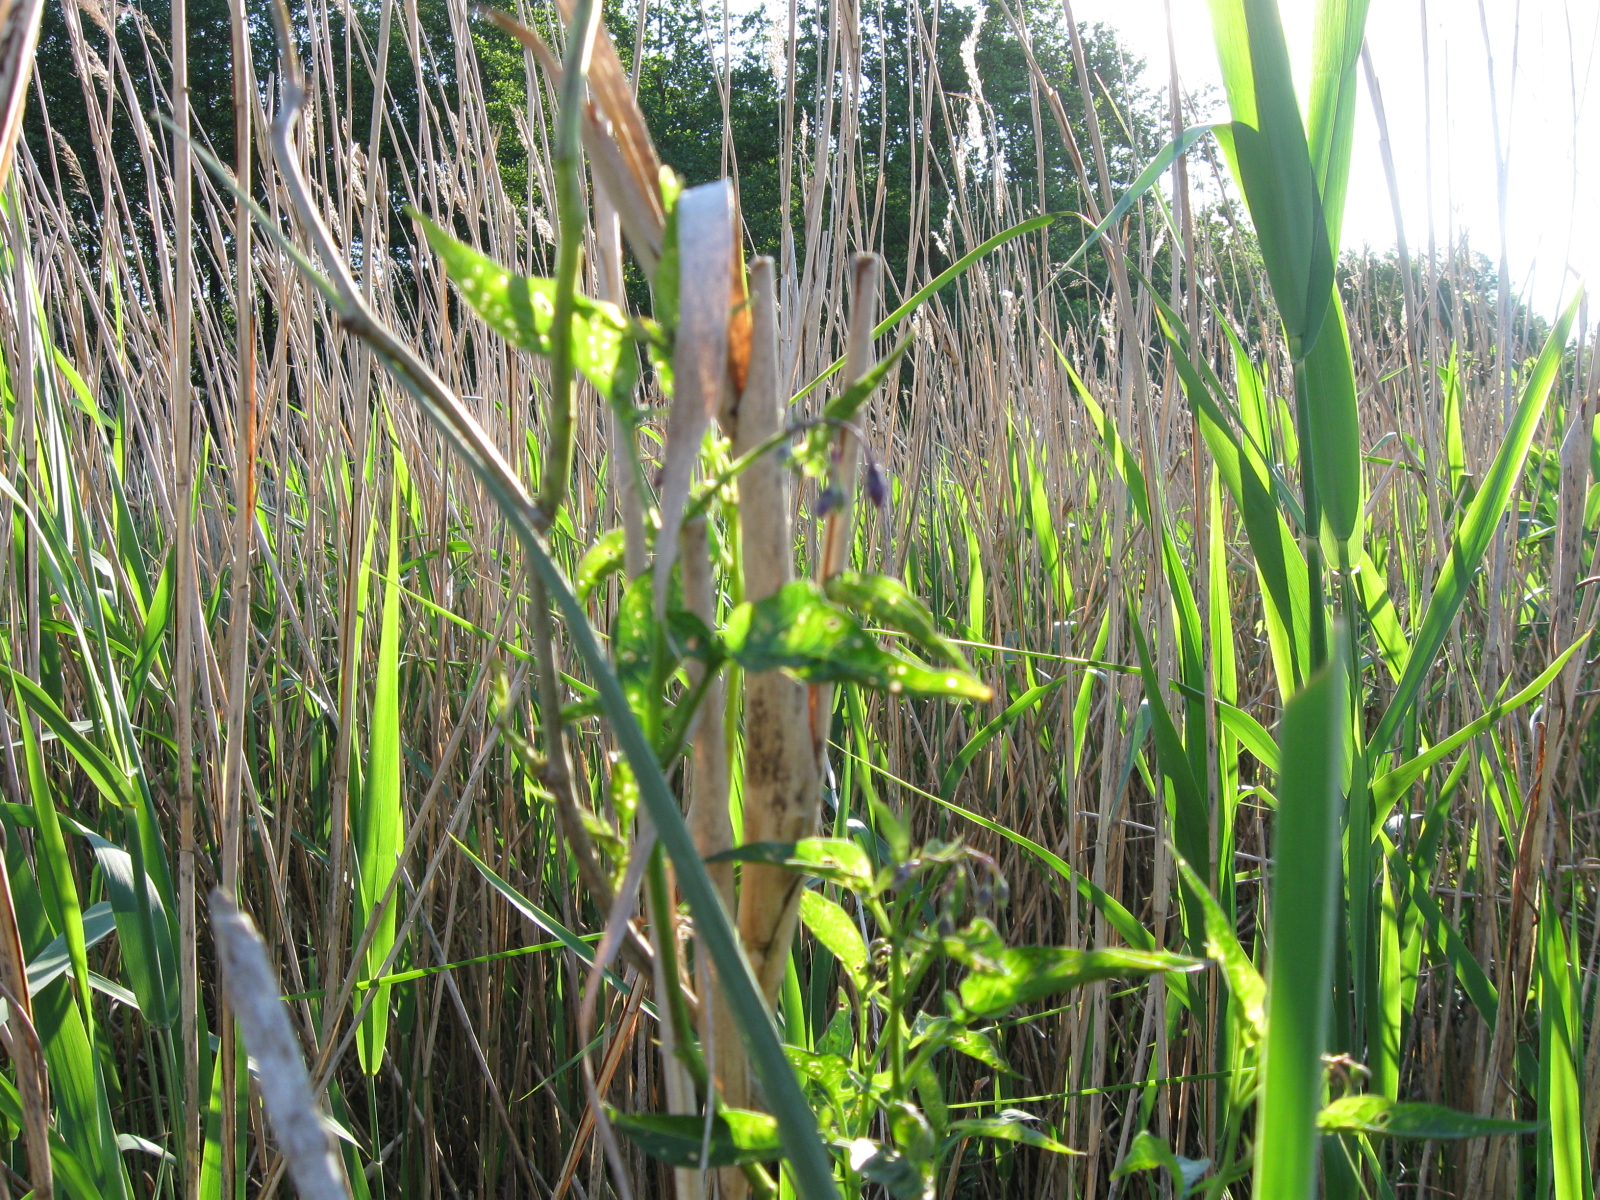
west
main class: Grassland
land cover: Spontaneously vegetated surfaces
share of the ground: > 75 %
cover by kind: herbaceous plants 100 %
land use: Semi-natural and natural areas not in use
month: June
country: LT
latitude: 54.4265
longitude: 23.8536
